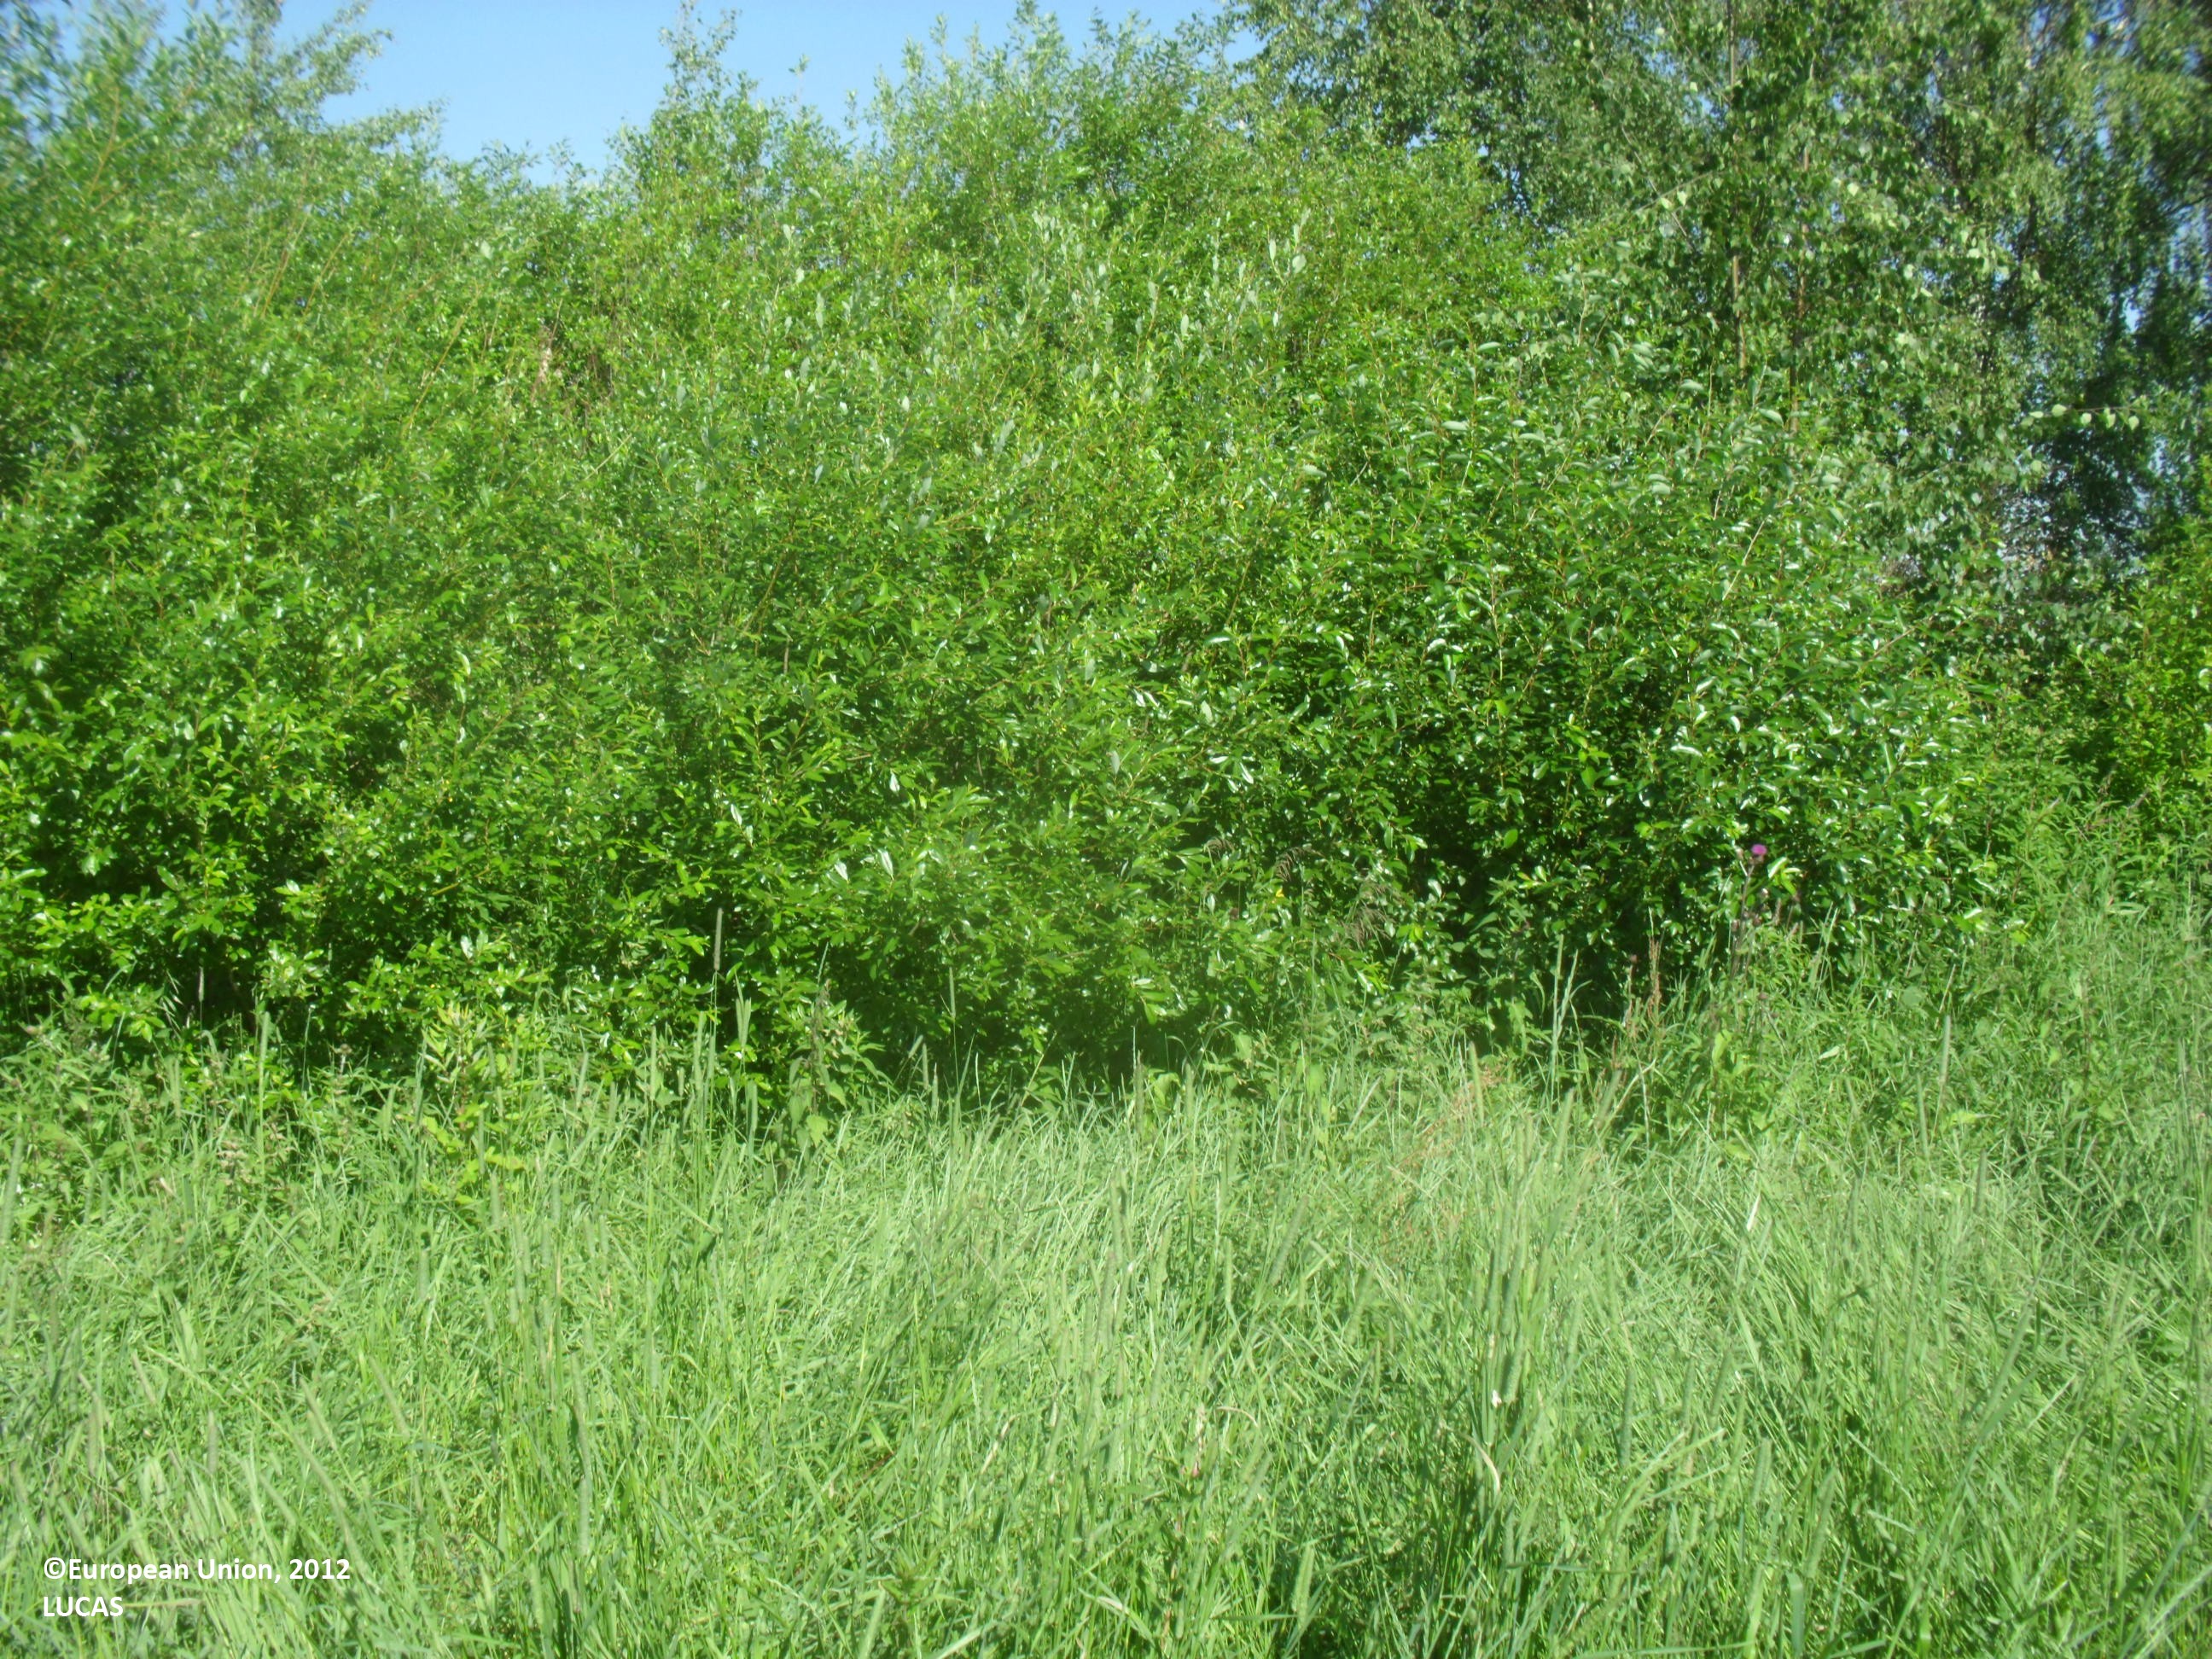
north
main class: Cropland
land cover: Temporary grasslands
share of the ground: > 75 %
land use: Agriculture (excluding fallow land and kitchen gardens)
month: July
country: FI
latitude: 63.1814
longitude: 23.8386
